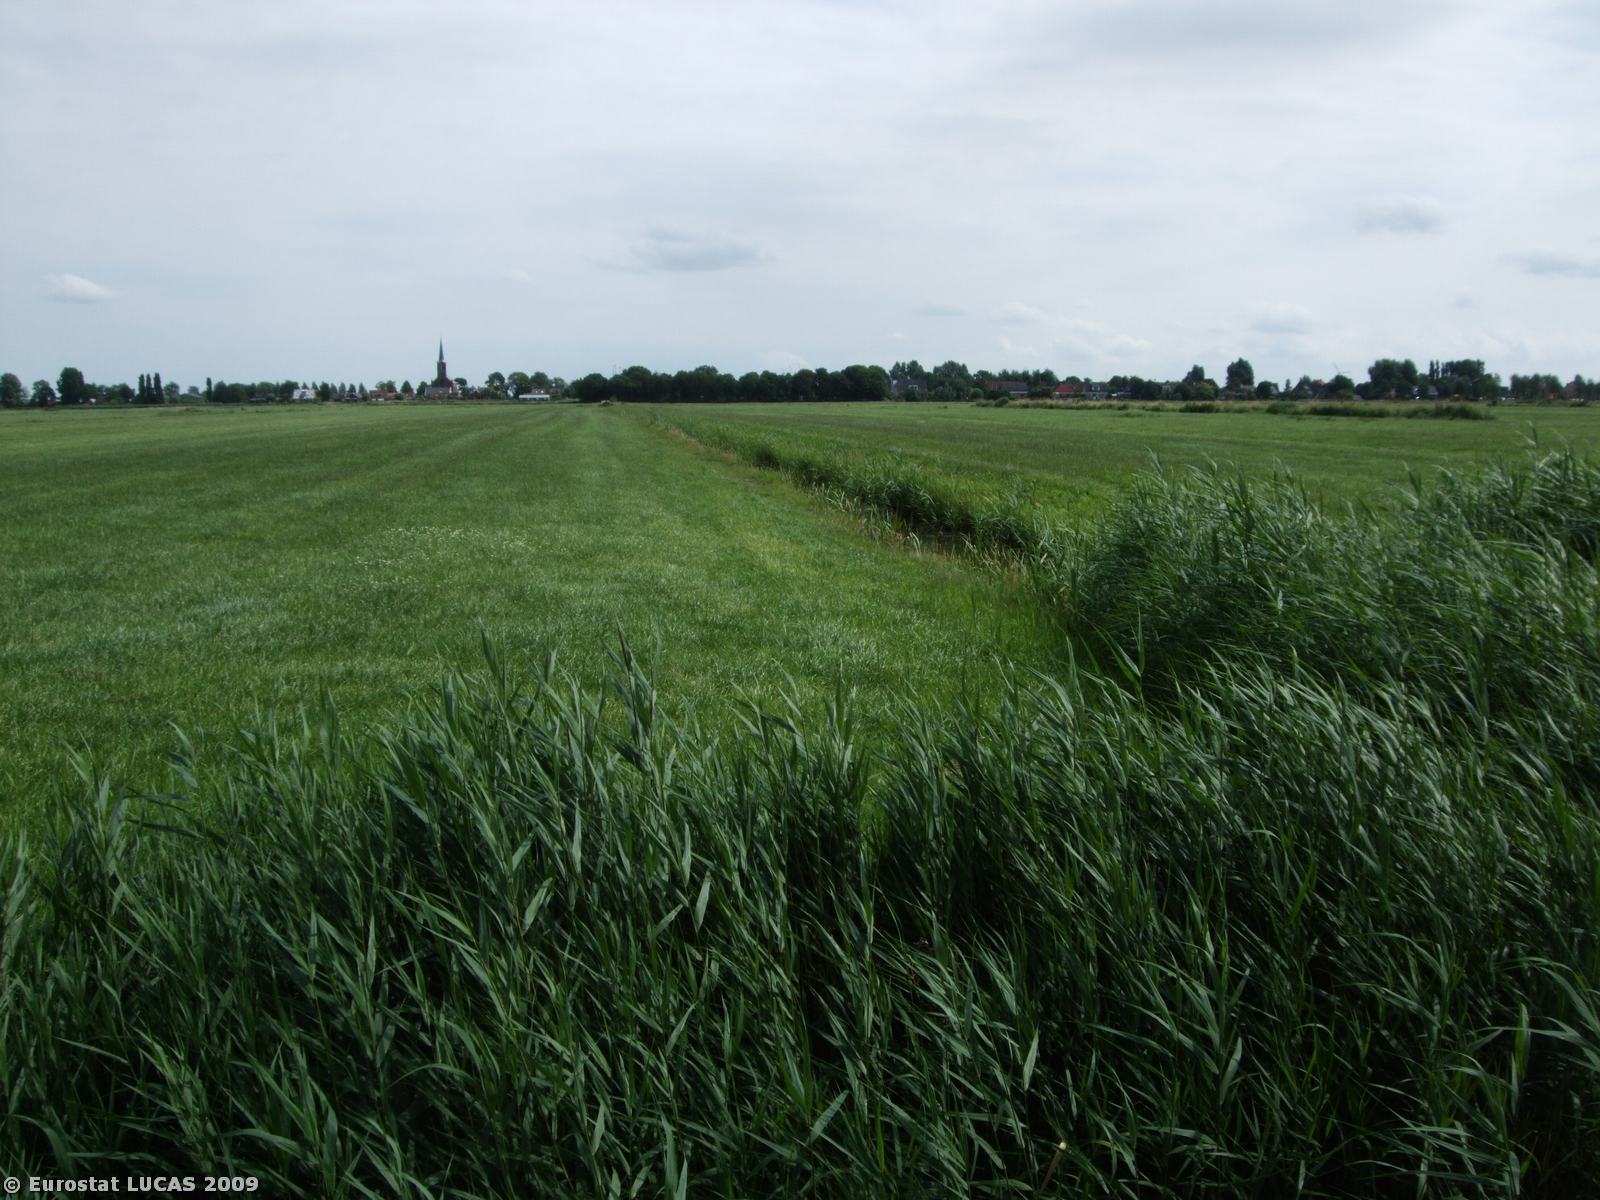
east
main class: Woodland
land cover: Broadleaved woodland
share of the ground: 50 - 75 %
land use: Road transport
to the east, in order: Grassland without tree/shrub cover; Ditches and canals; Grassland without tree/shrub cover
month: July
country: NL
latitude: 52.9813
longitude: 5.6349
